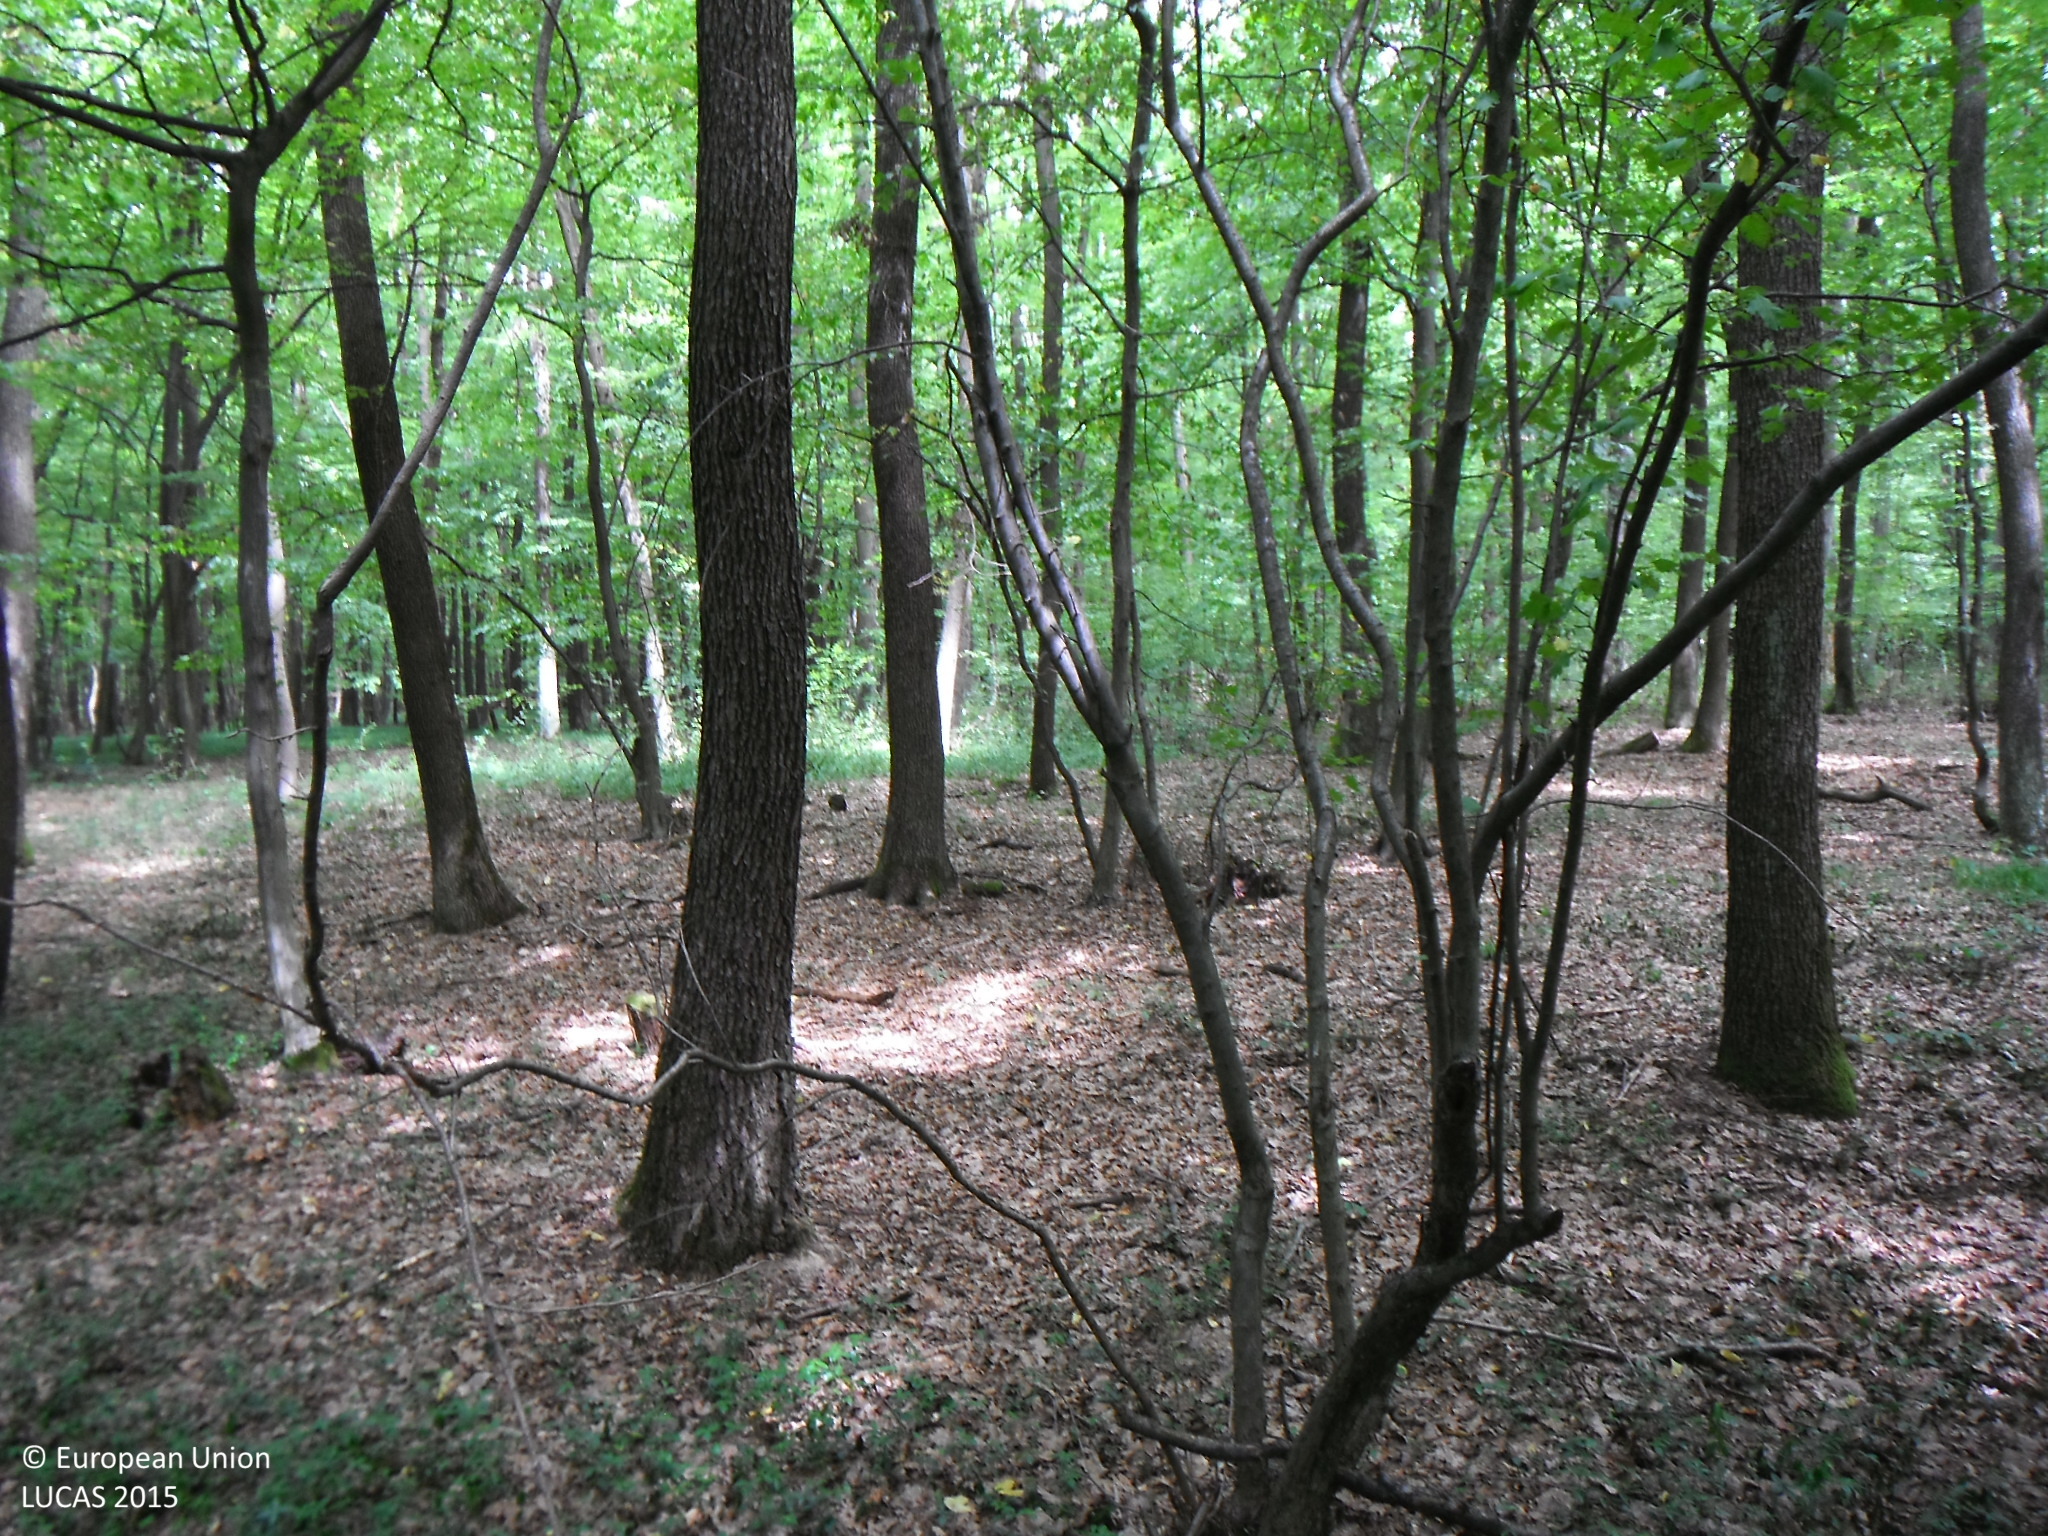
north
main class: Woodland
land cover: Broadleaved woodland
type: acidophilous oak and oak-birch forest
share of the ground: > 75 %
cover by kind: broadleaved forest trees 100 %
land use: Forestry
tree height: > 5 m
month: July
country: SK
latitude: 48.6934
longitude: 21.3075
